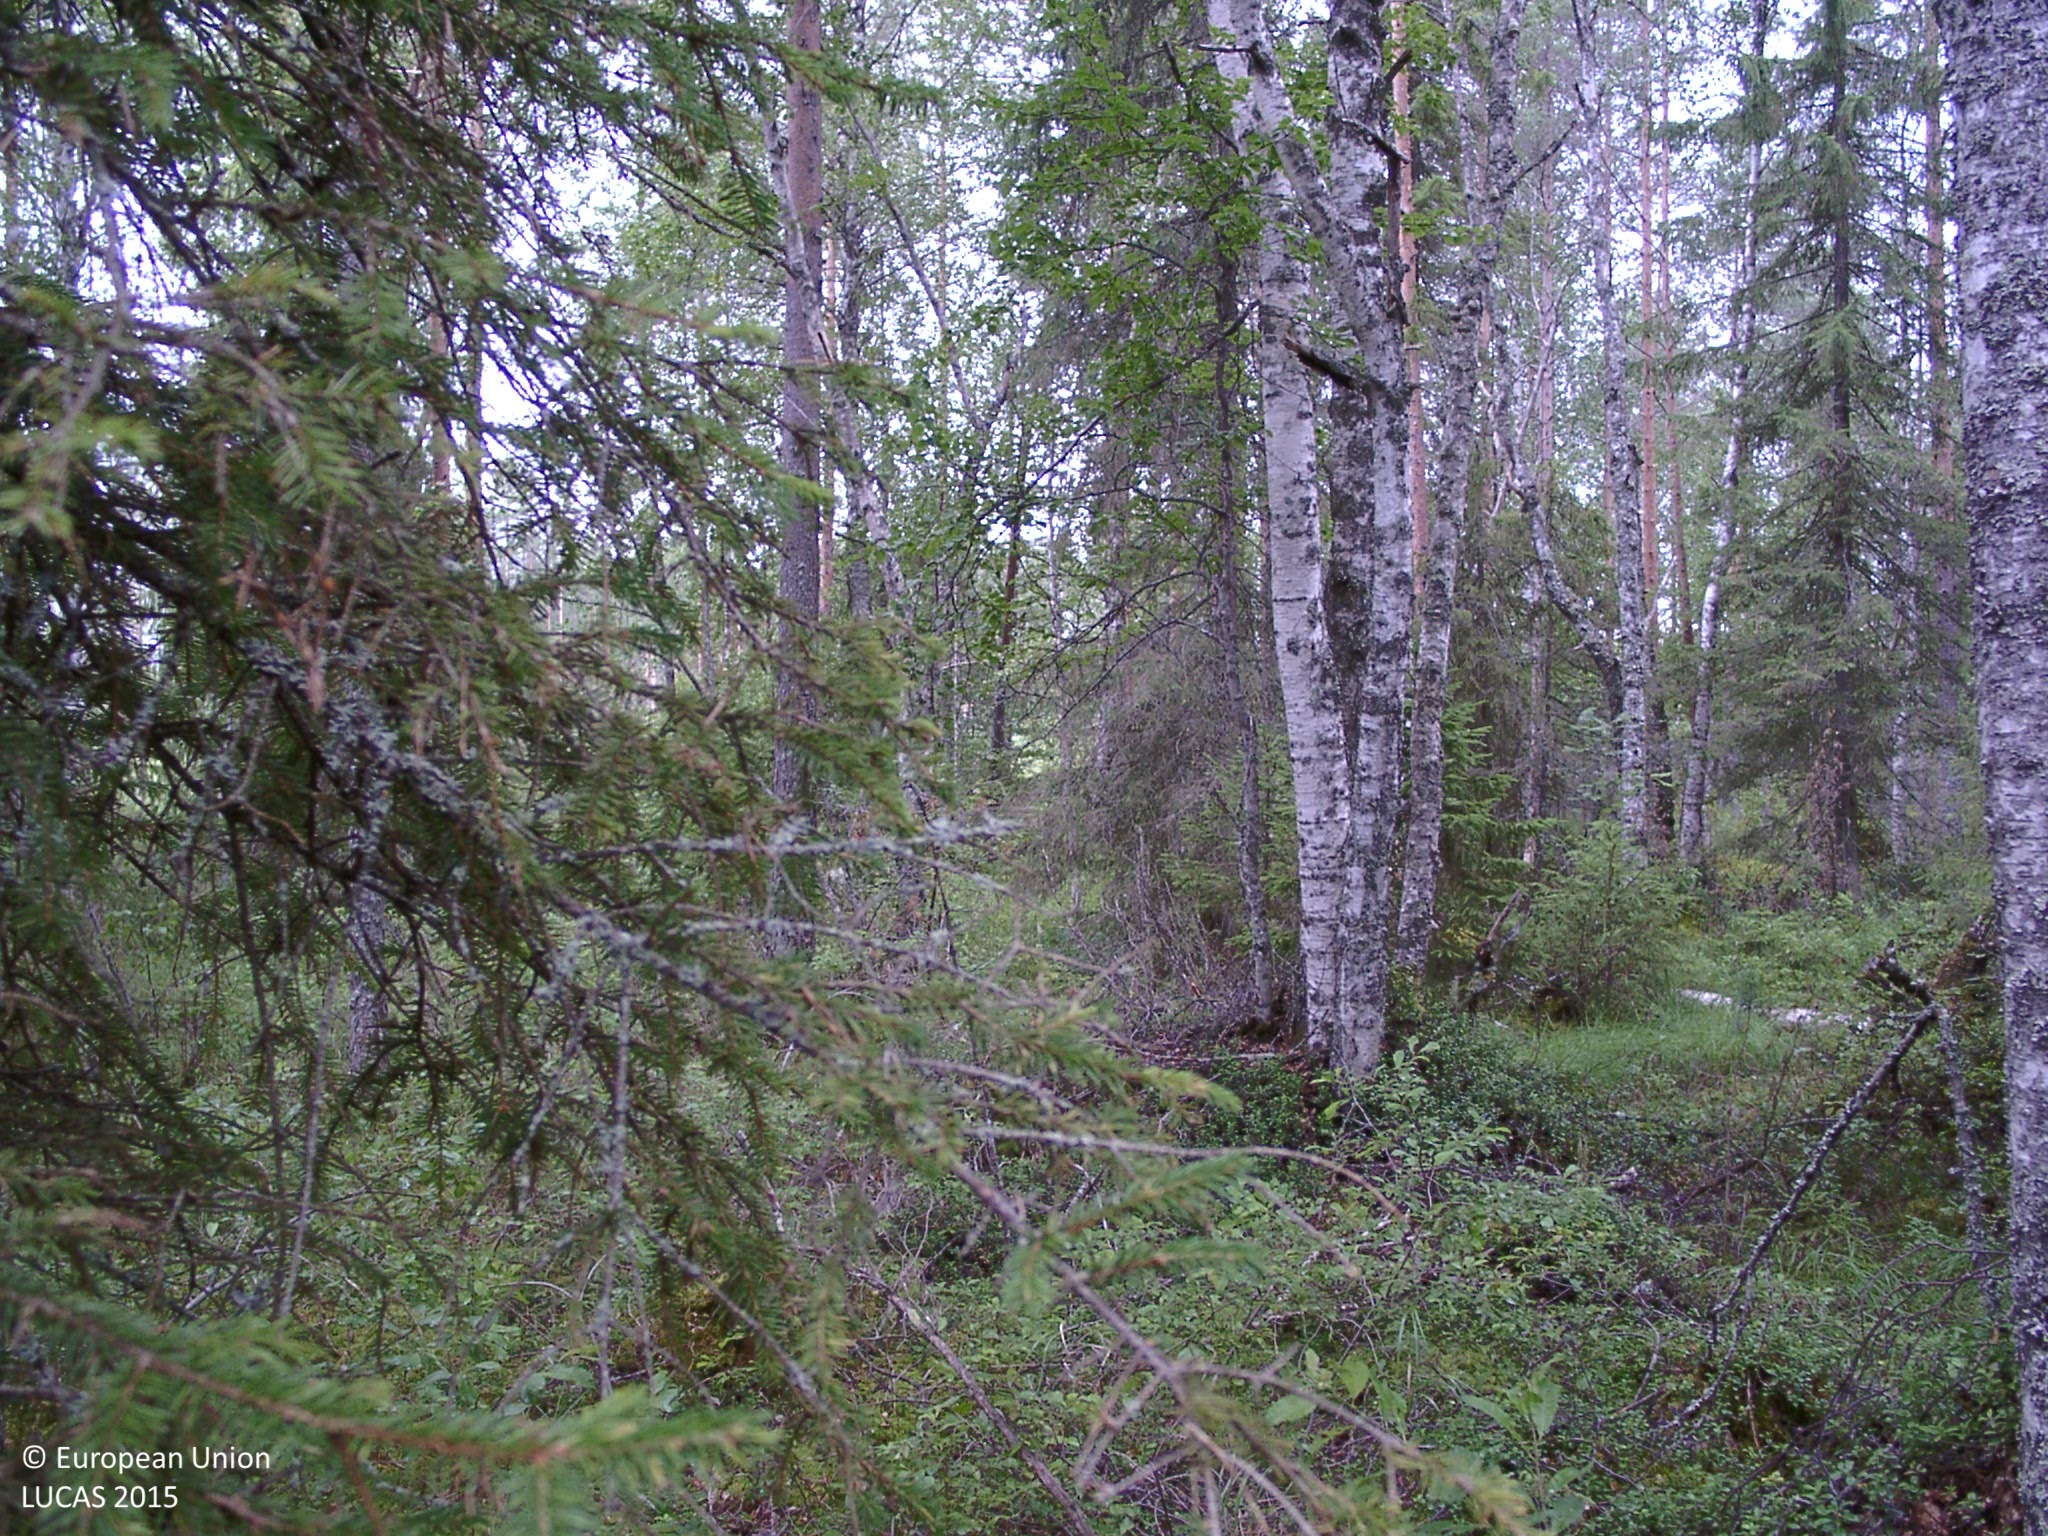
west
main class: Woodland
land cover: Other mixed woodland
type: boreal forest
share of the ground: 50 - 75 %
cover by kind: coniferous forest trees 35 %, broadleaved forest trees 30 %, shrubs 20 %, lichens and mosses 10 %, herbaceous plants 5 %
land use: Forestry
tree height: > 5 m
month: August
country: FI
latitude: 62.7813
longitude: 24.5709
